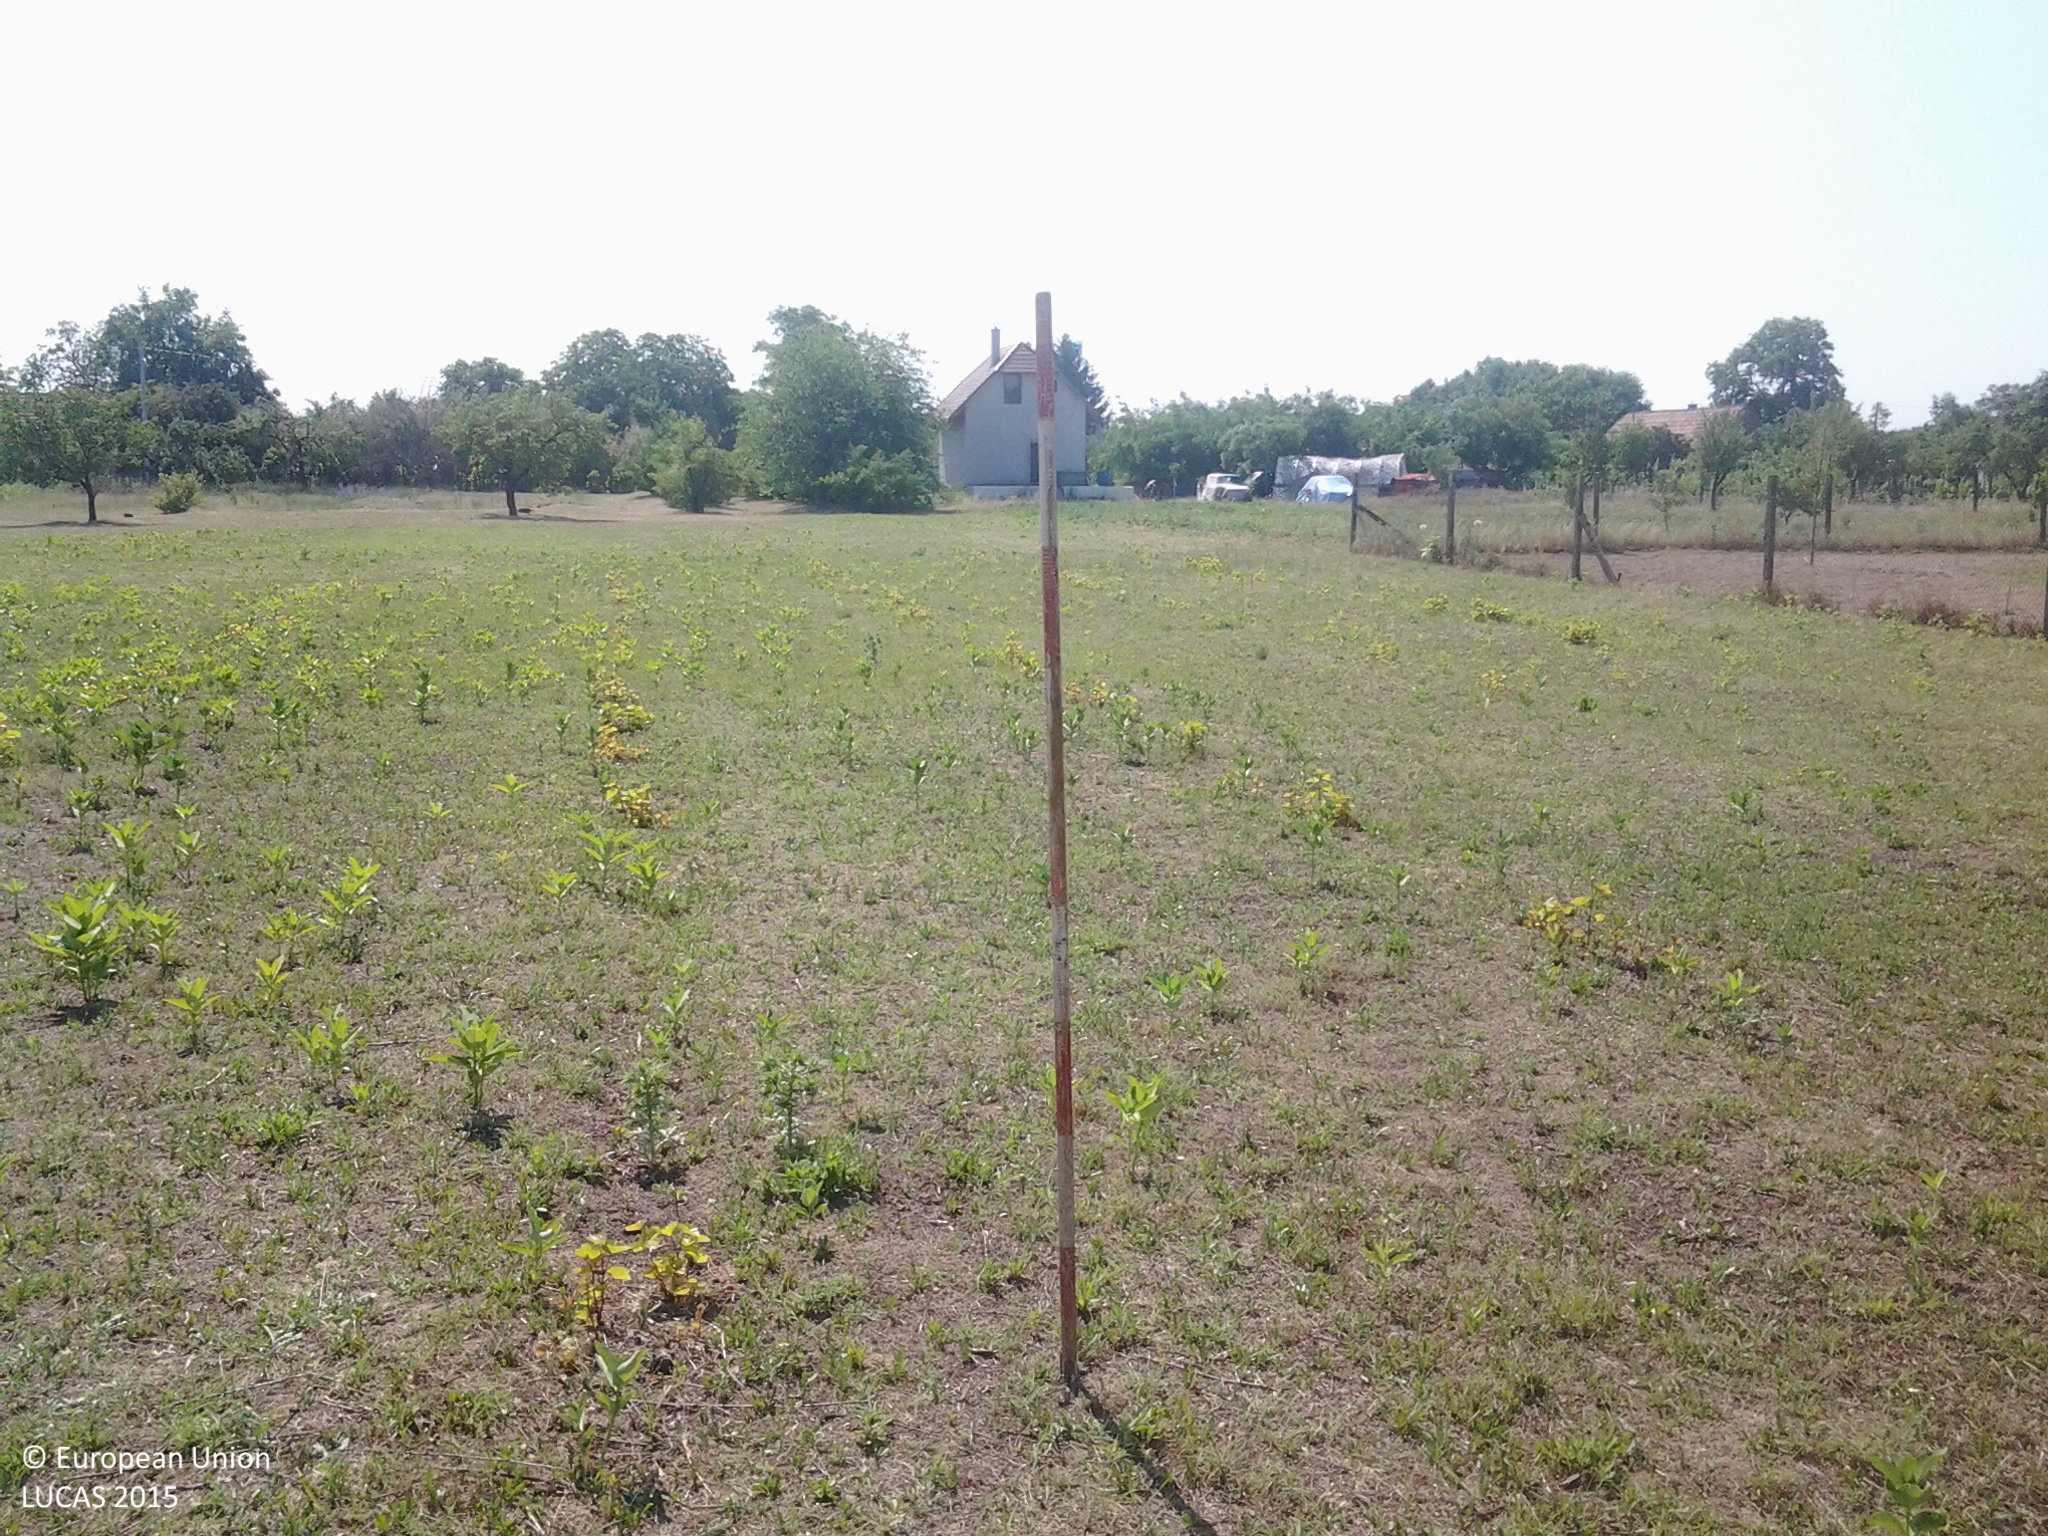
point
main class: Grassland
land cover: Spontaneously vegetated surfaces
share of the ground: > 75 %
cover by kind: herbaceous plants 95 %, unconsolidated bare surface 5 %
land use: Fallow land
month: June
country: HU
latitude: 46.9140
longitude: 19.6183
